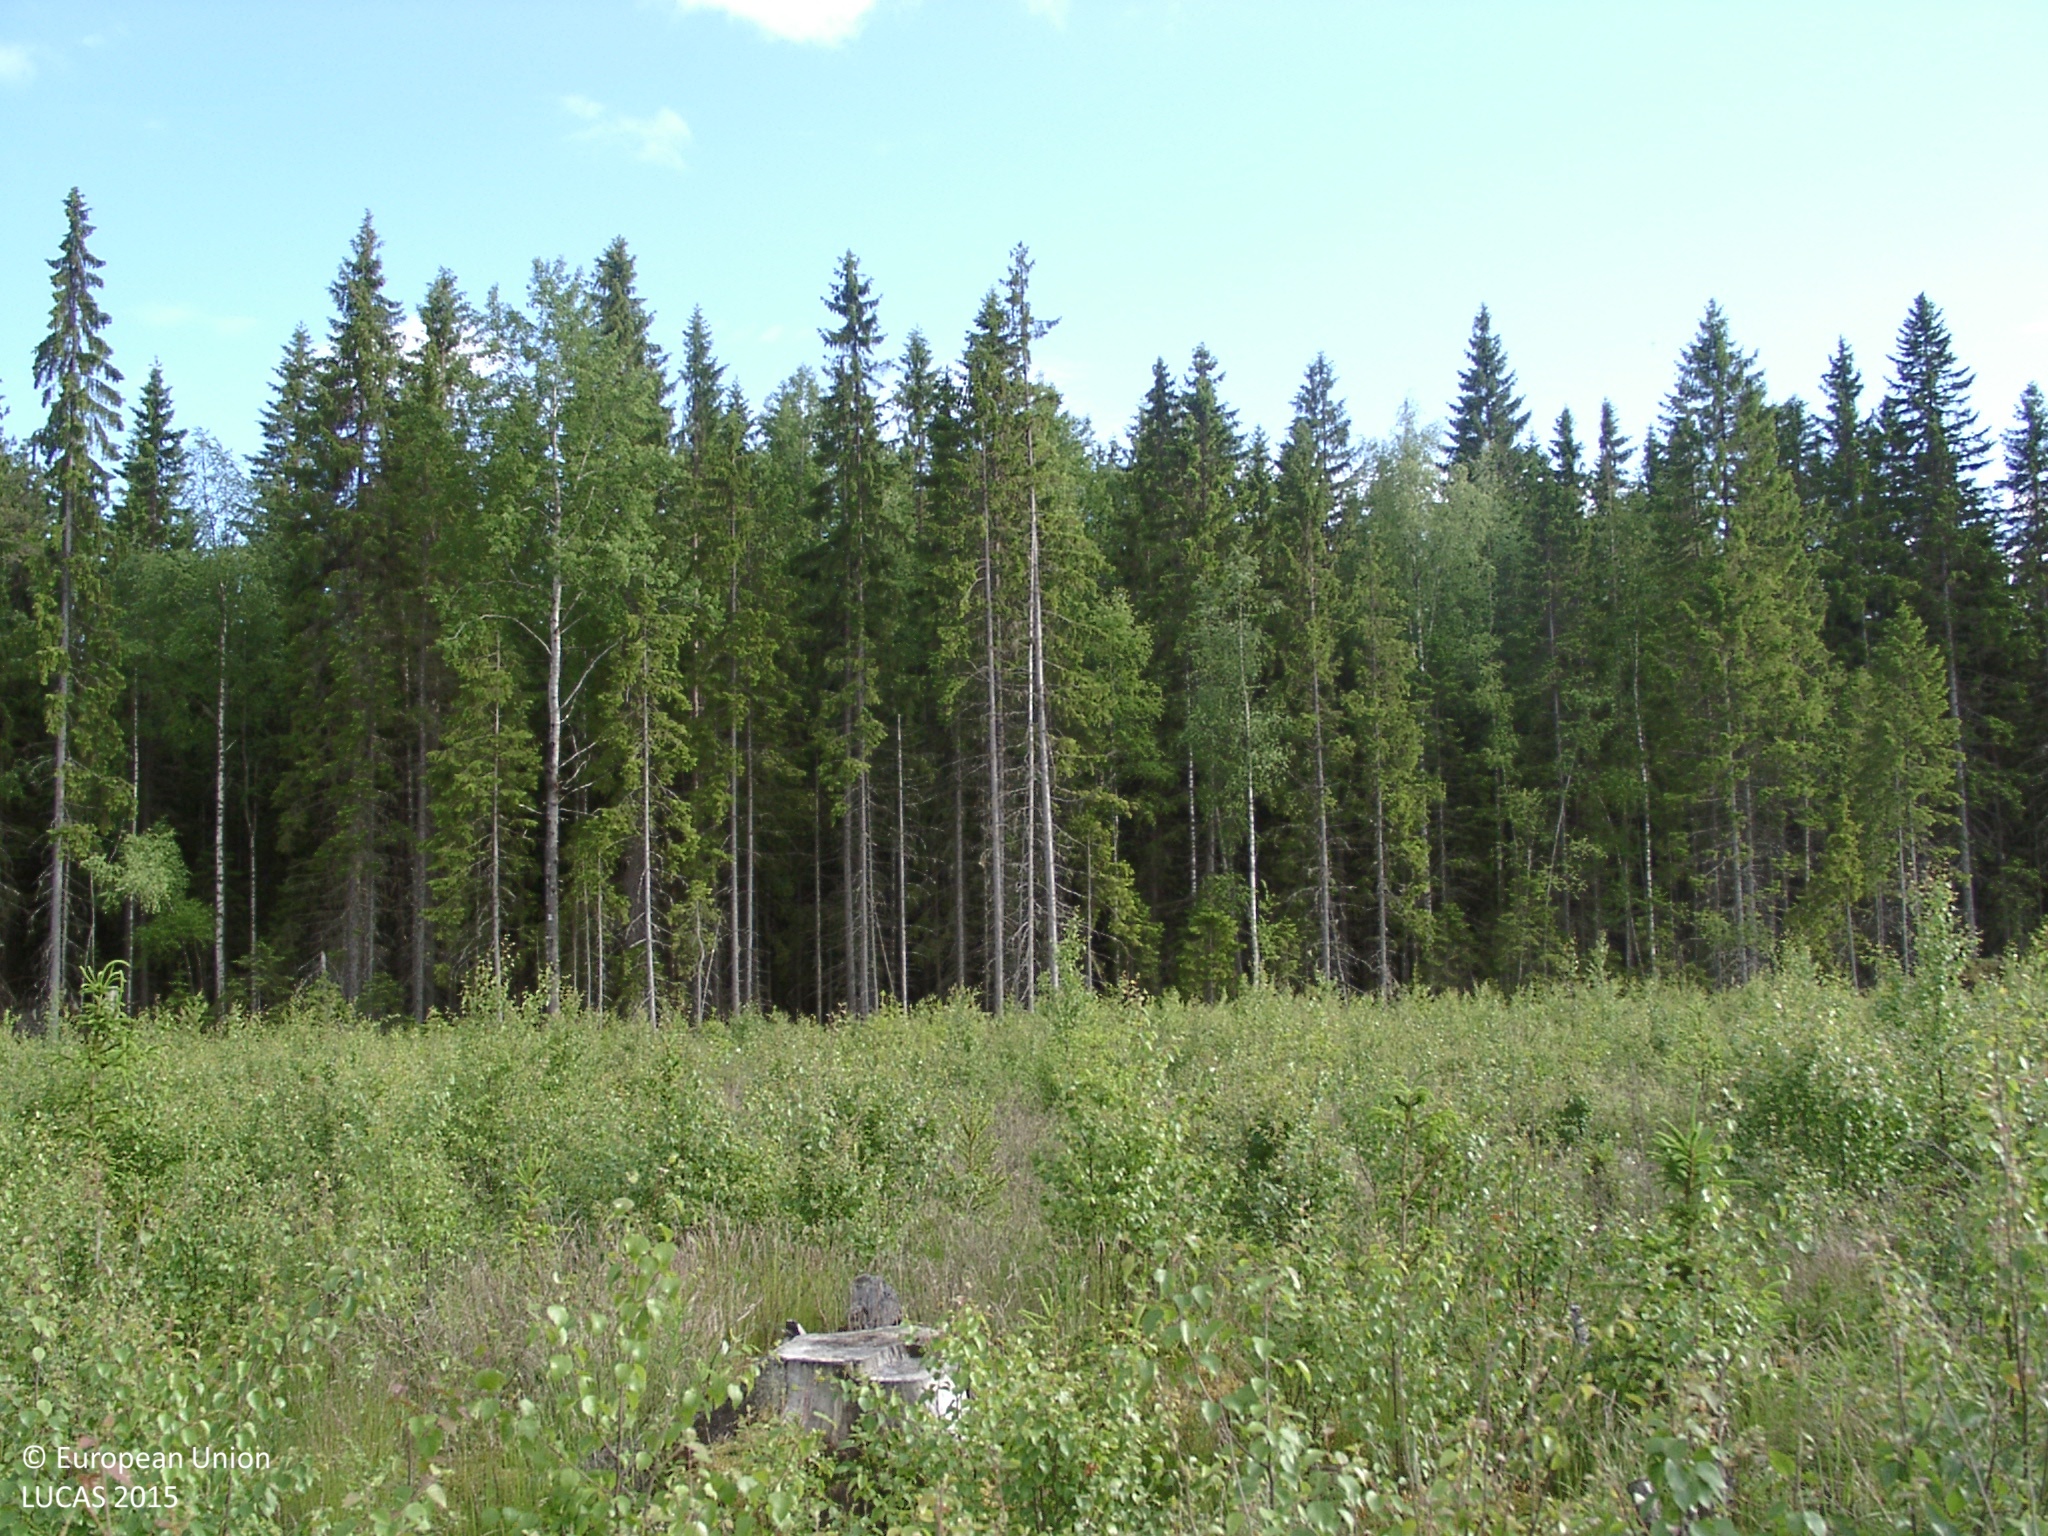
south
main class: Woodland
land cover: Broadleaved woodland
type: non-riverine alder, birch or aspen forest
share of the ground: 25 - 50 %
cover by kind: broadleaved forest trees 35 %, shrubs 25 %, herbaceous plants 25 %, coniferous forest trees 10 %, lichens and mosses 5 %
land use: Forestry
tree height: < 5 m
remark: Nursery
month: June
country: FI
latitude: 61.9314
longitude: 24.7892
